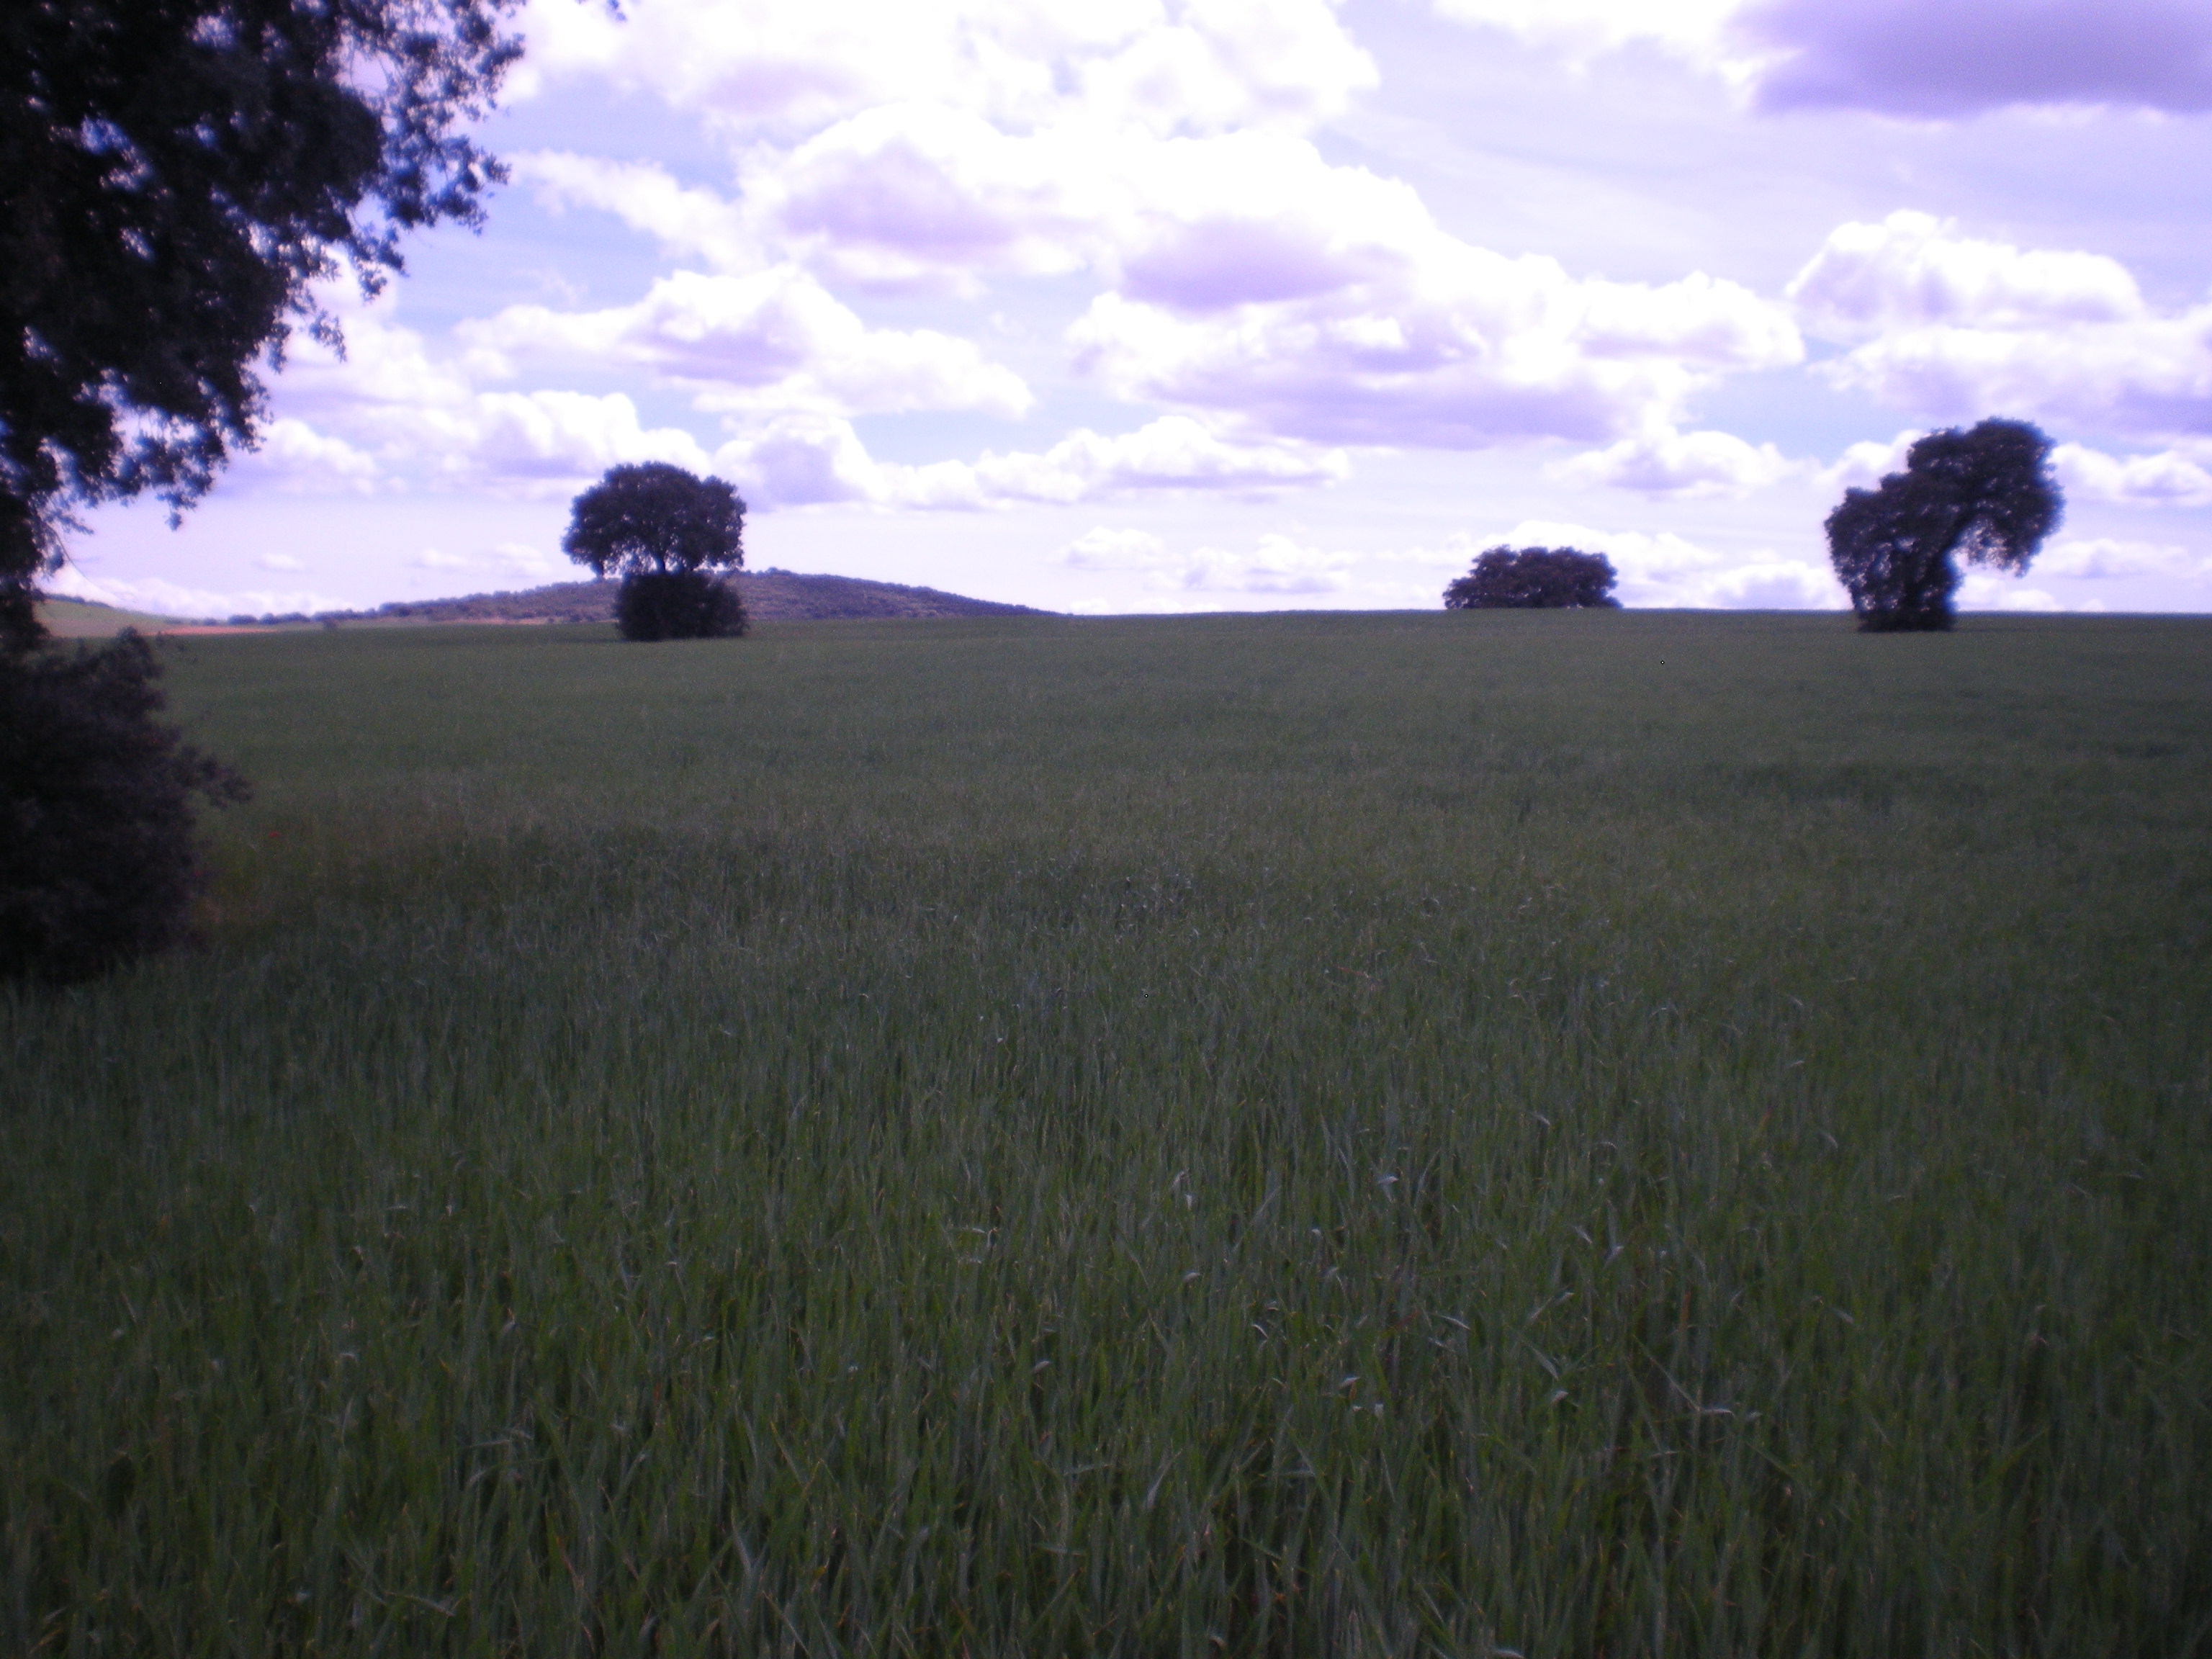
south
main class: Cropland
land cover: Common wheat
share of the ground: > 75 %
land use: Agriculture (excluding fallow land and kitchen gardens)
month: April
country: ES
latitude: 38.6259
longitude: -3.1587
